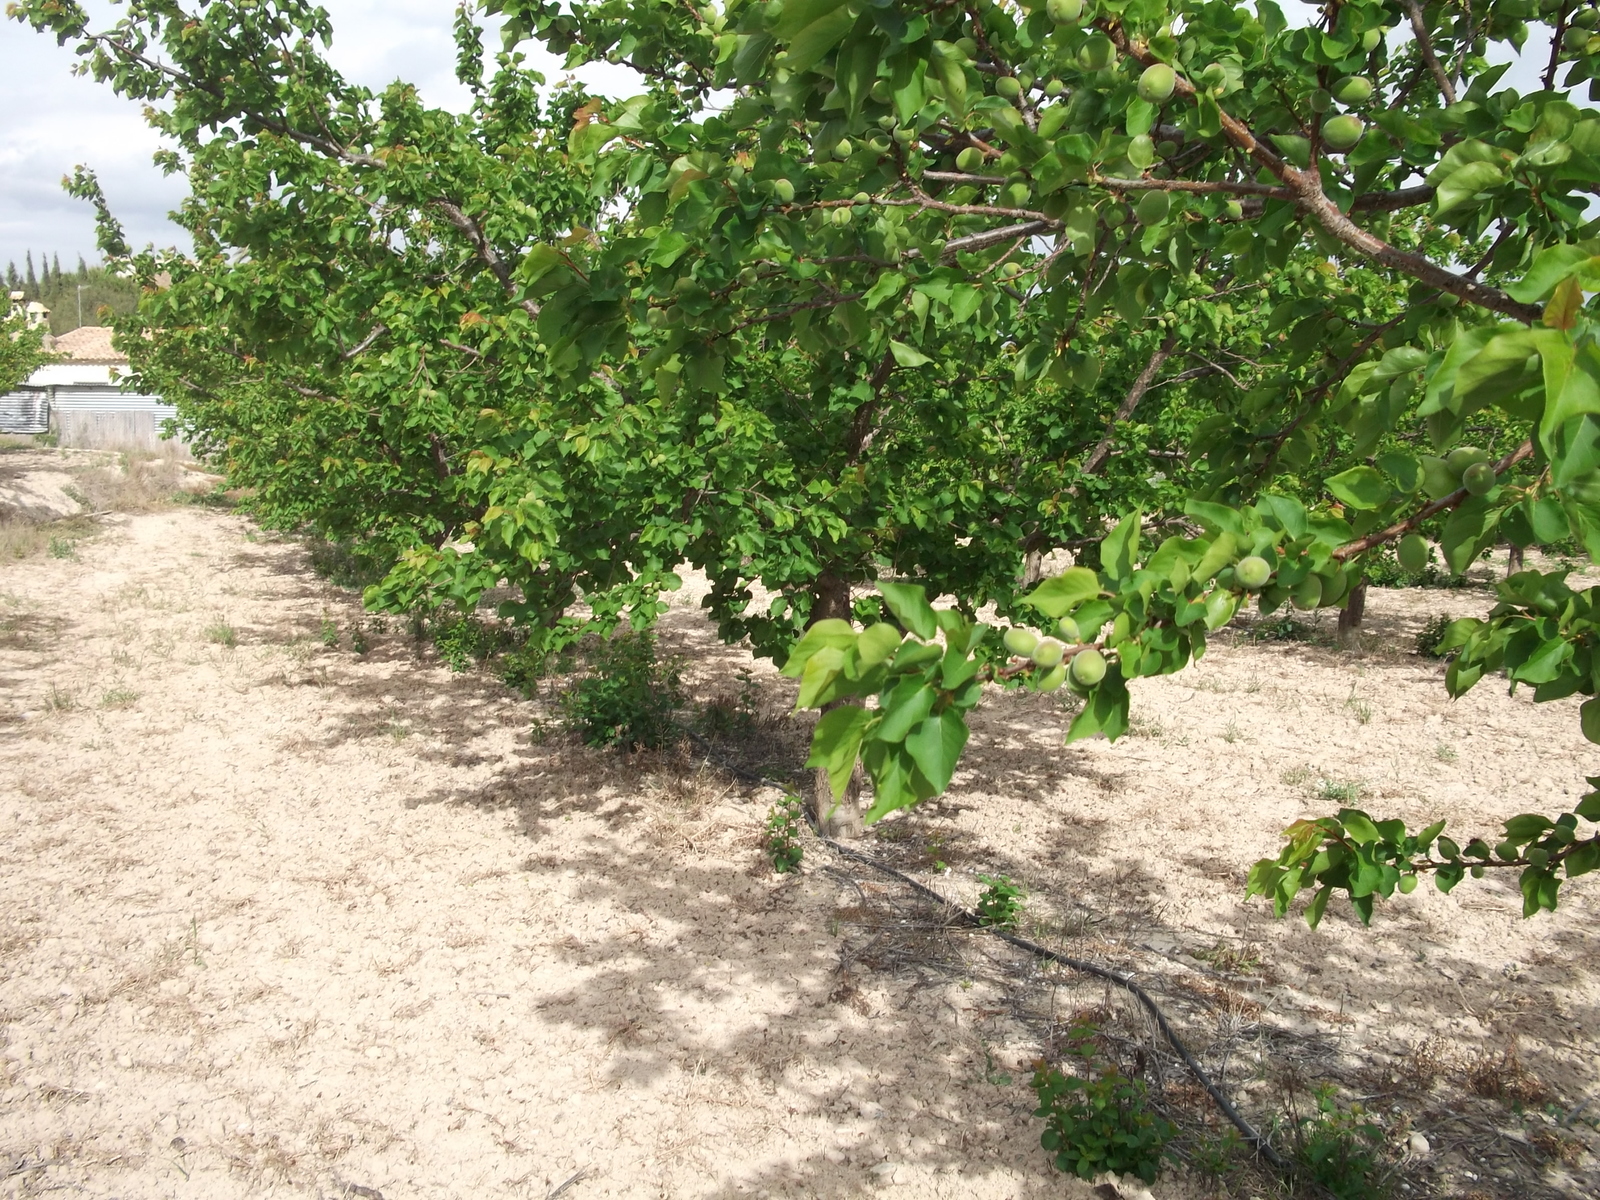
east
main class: Cropland
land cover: Other fruit trees and berries
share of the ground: 10 - 25 %
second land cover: Other bare soil
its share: > 75 %
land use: Agriculture (excluding fallow land and kitchen gardens)
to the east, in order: Other fruit trees and berries; Other bare soil; Grass margins; Spontaneously vegetated surfaces; Fences; Artificial constructions in urban areas; Fences; Tracks; Grass margins; Other fruit trees and berries; Grass margins; Other fruit trees and berries; Grass margins; Other fruit trees and berries; Fences; Artificial constructions in urban areas
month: April
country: ES
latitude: 38.0321
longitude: -1.5274
